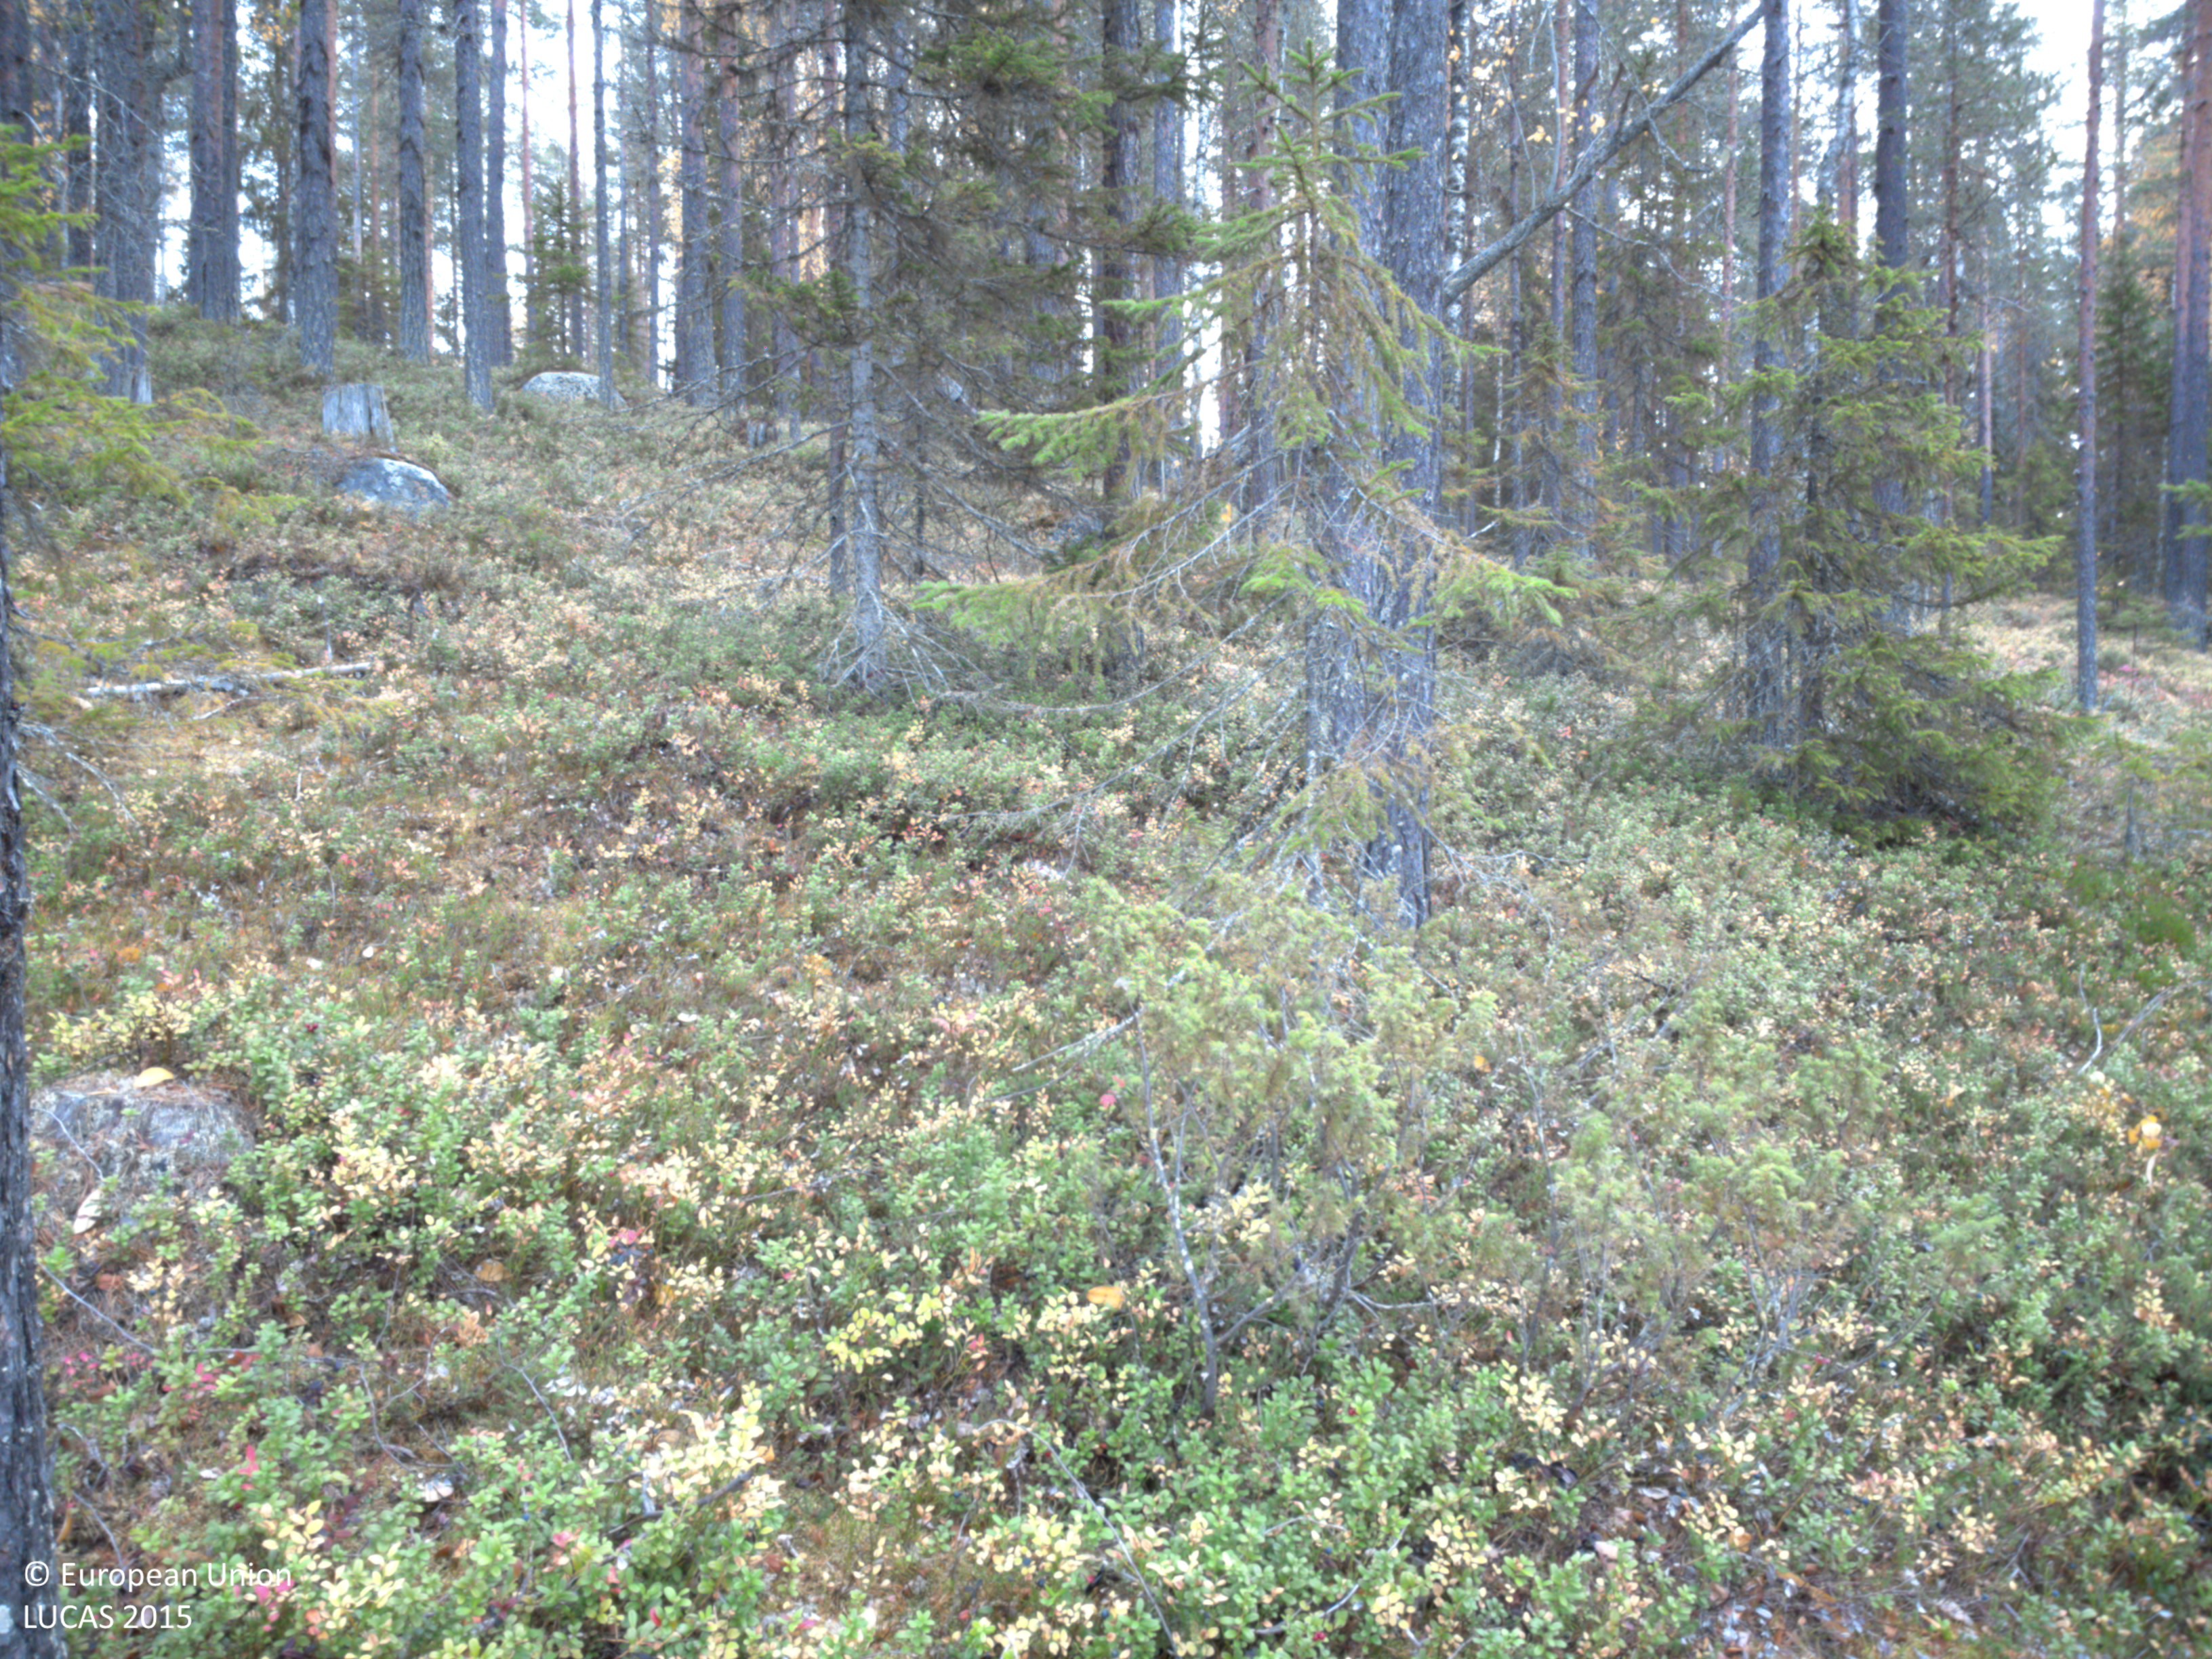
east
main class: Woodland
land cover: Pine dominated coniferous woodland
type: boreal forest
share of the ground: 50 - 75 %
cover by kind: coniferous forest trees 70 %, shrubs 20 %, herbaceous plants 5 %, lichens and mosses 5 %
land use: Forestry
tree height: > 5 m
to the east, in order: Pine dominated coniferous woodland; Pine dominated mixed woodland; Other coniferous woodland; Spruce dominated coniferous woodland; Pine dominated mixed woodland; Spruce dominated coniferous woodland; Ditches and canals; Pine dominated mixed woodland; Grassland with sparse tree/shrub cover; Broadleaved woodland; Grassland with sparse tree/shrub cover
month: October
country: SE
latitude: 64.6987
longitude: 18.1238
